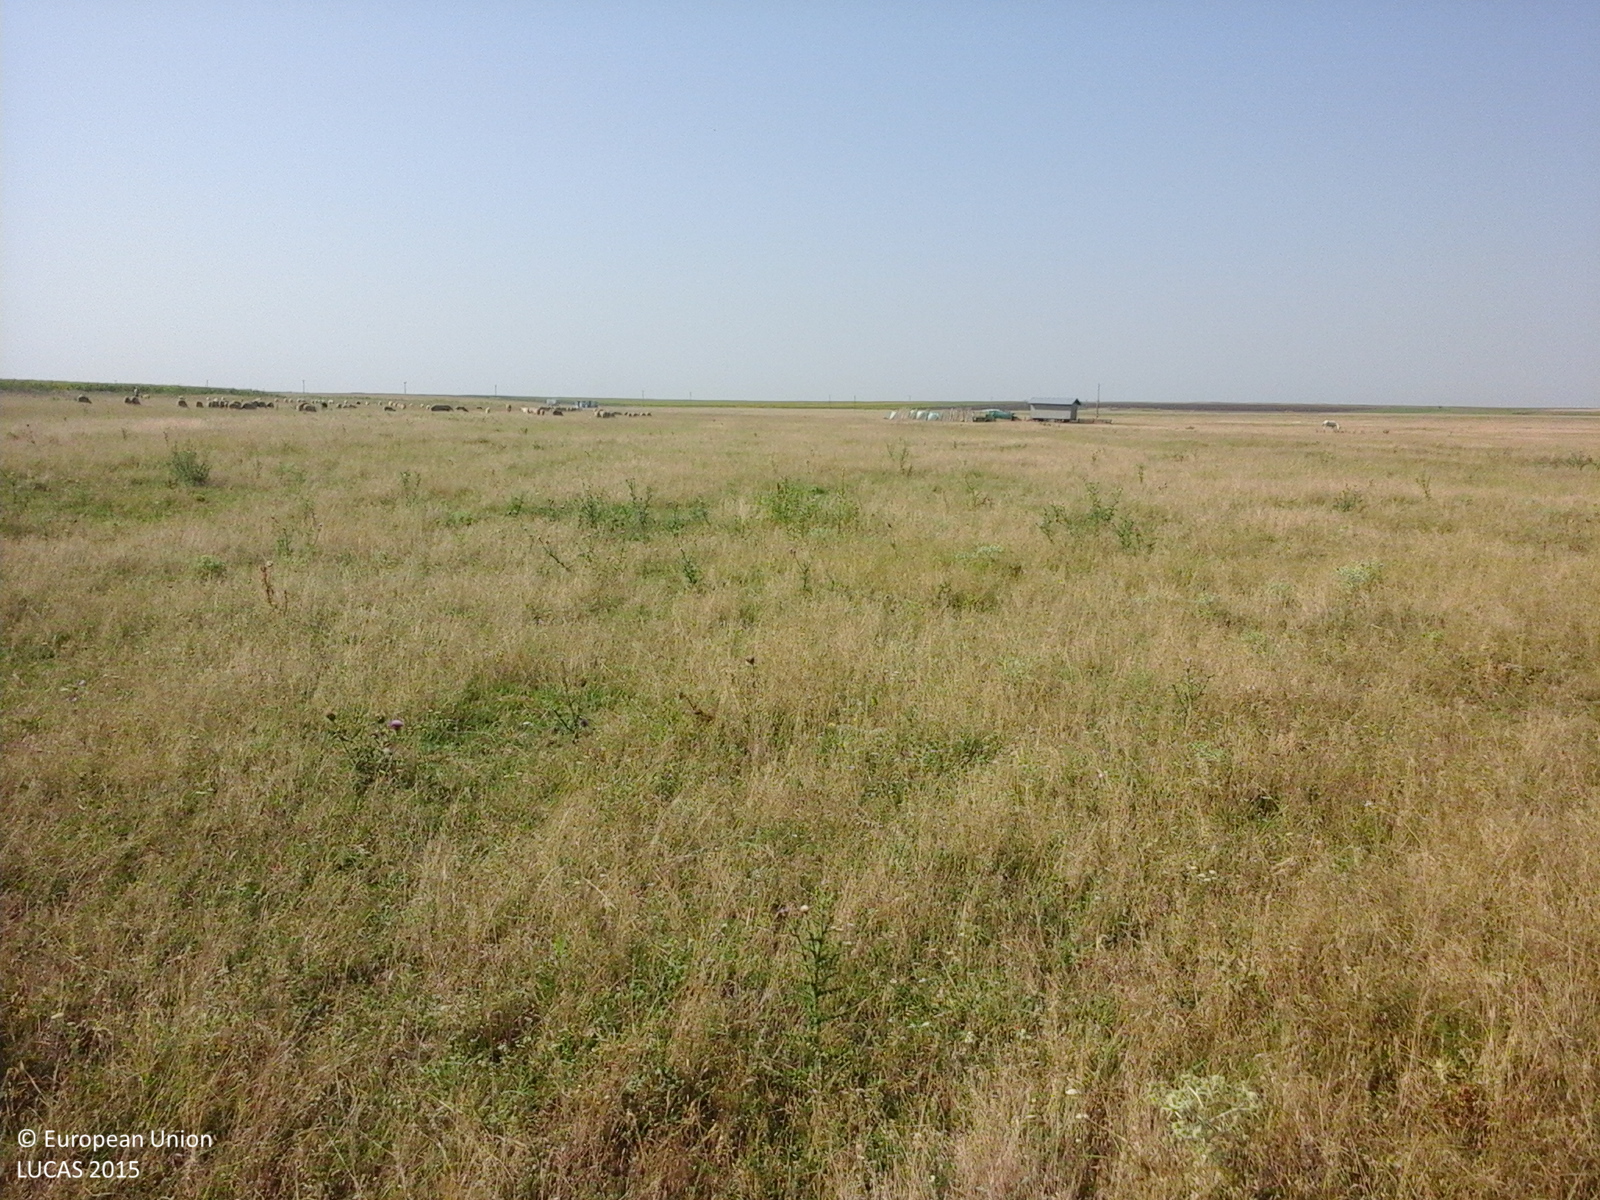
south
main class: Grassland
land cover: Grassland without tree/shrub cover
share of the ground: > 75 %
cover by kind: herbaceous plants 100 %
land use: Agriculture (excluding fallow land and kitchen gardens)
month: July
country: RO
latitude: 44.8129
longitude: 27.3256
